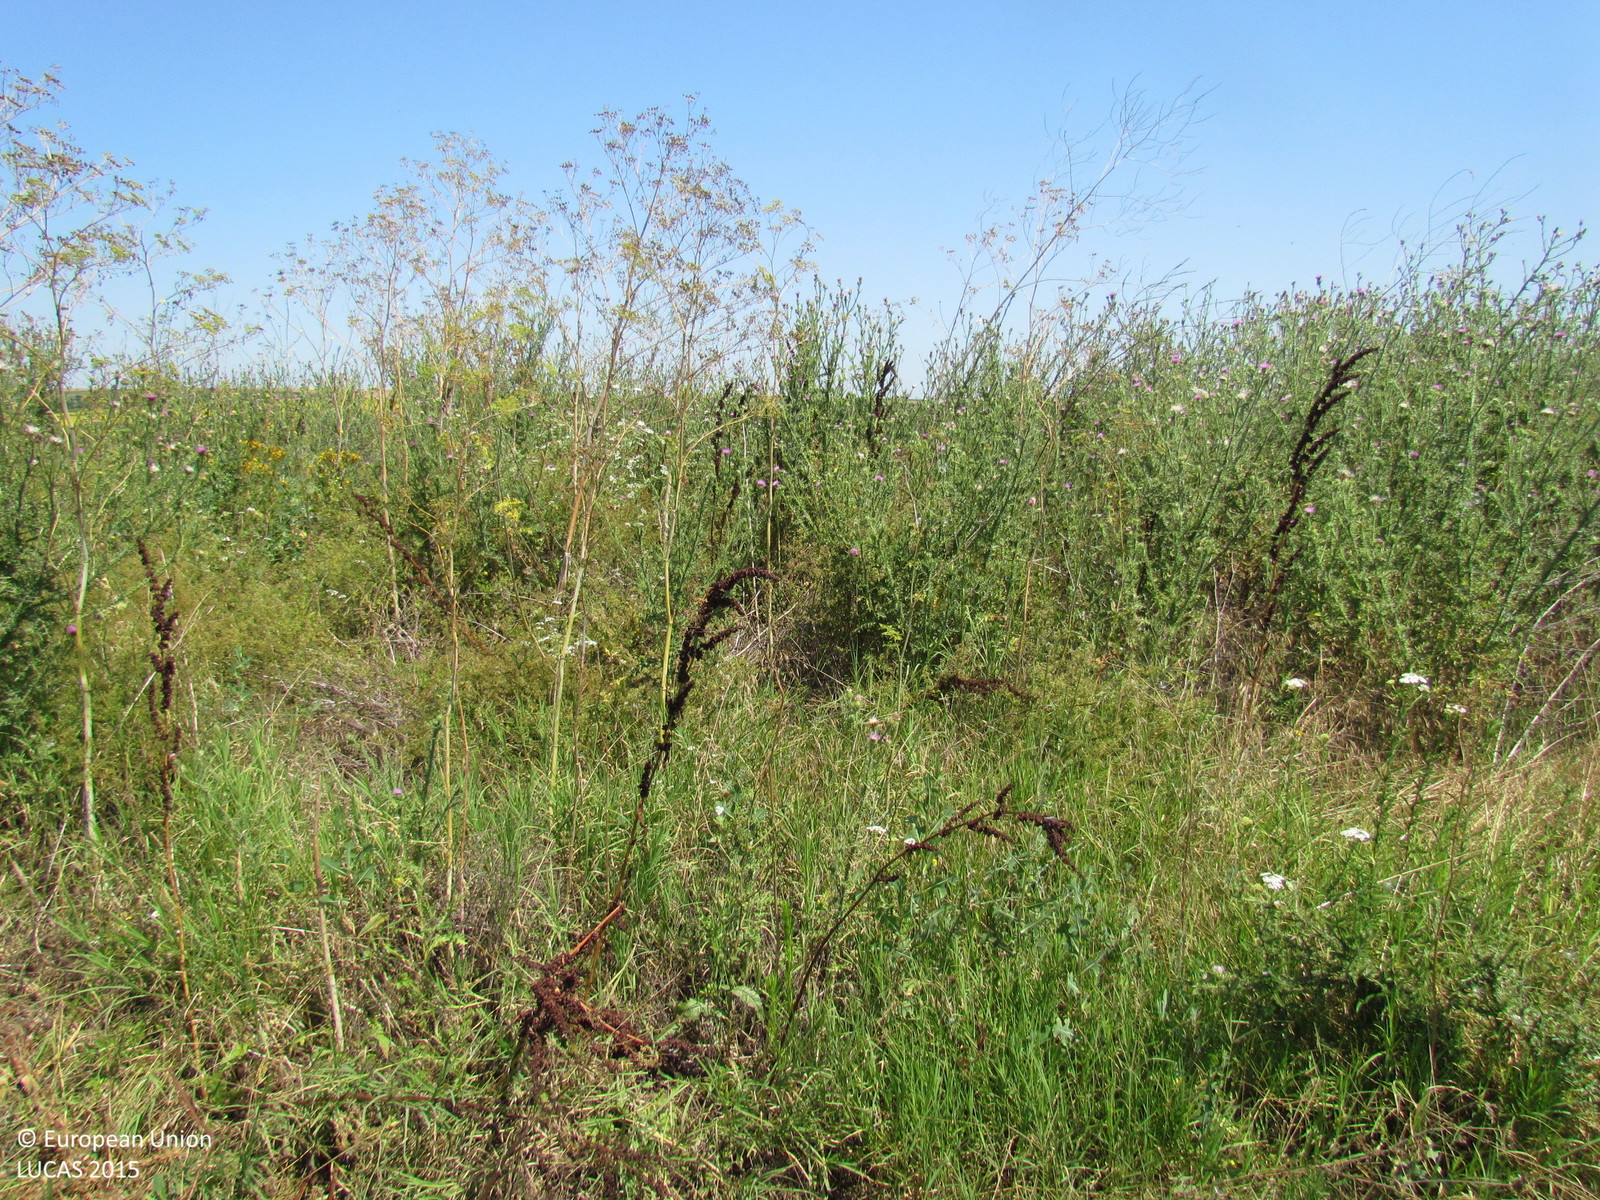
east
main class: Cropland
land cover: Sunflower
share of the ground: > 75 %
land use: Agriculture (excluding fallow land and kitchen gardens)
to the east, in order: Sunflower; Grass margins; Tracks; Grass margins; Ditches and canals; Grass margins; Other non-permanent industrial crops
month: July
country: BG
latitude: 42.4260
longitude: 27.2849
